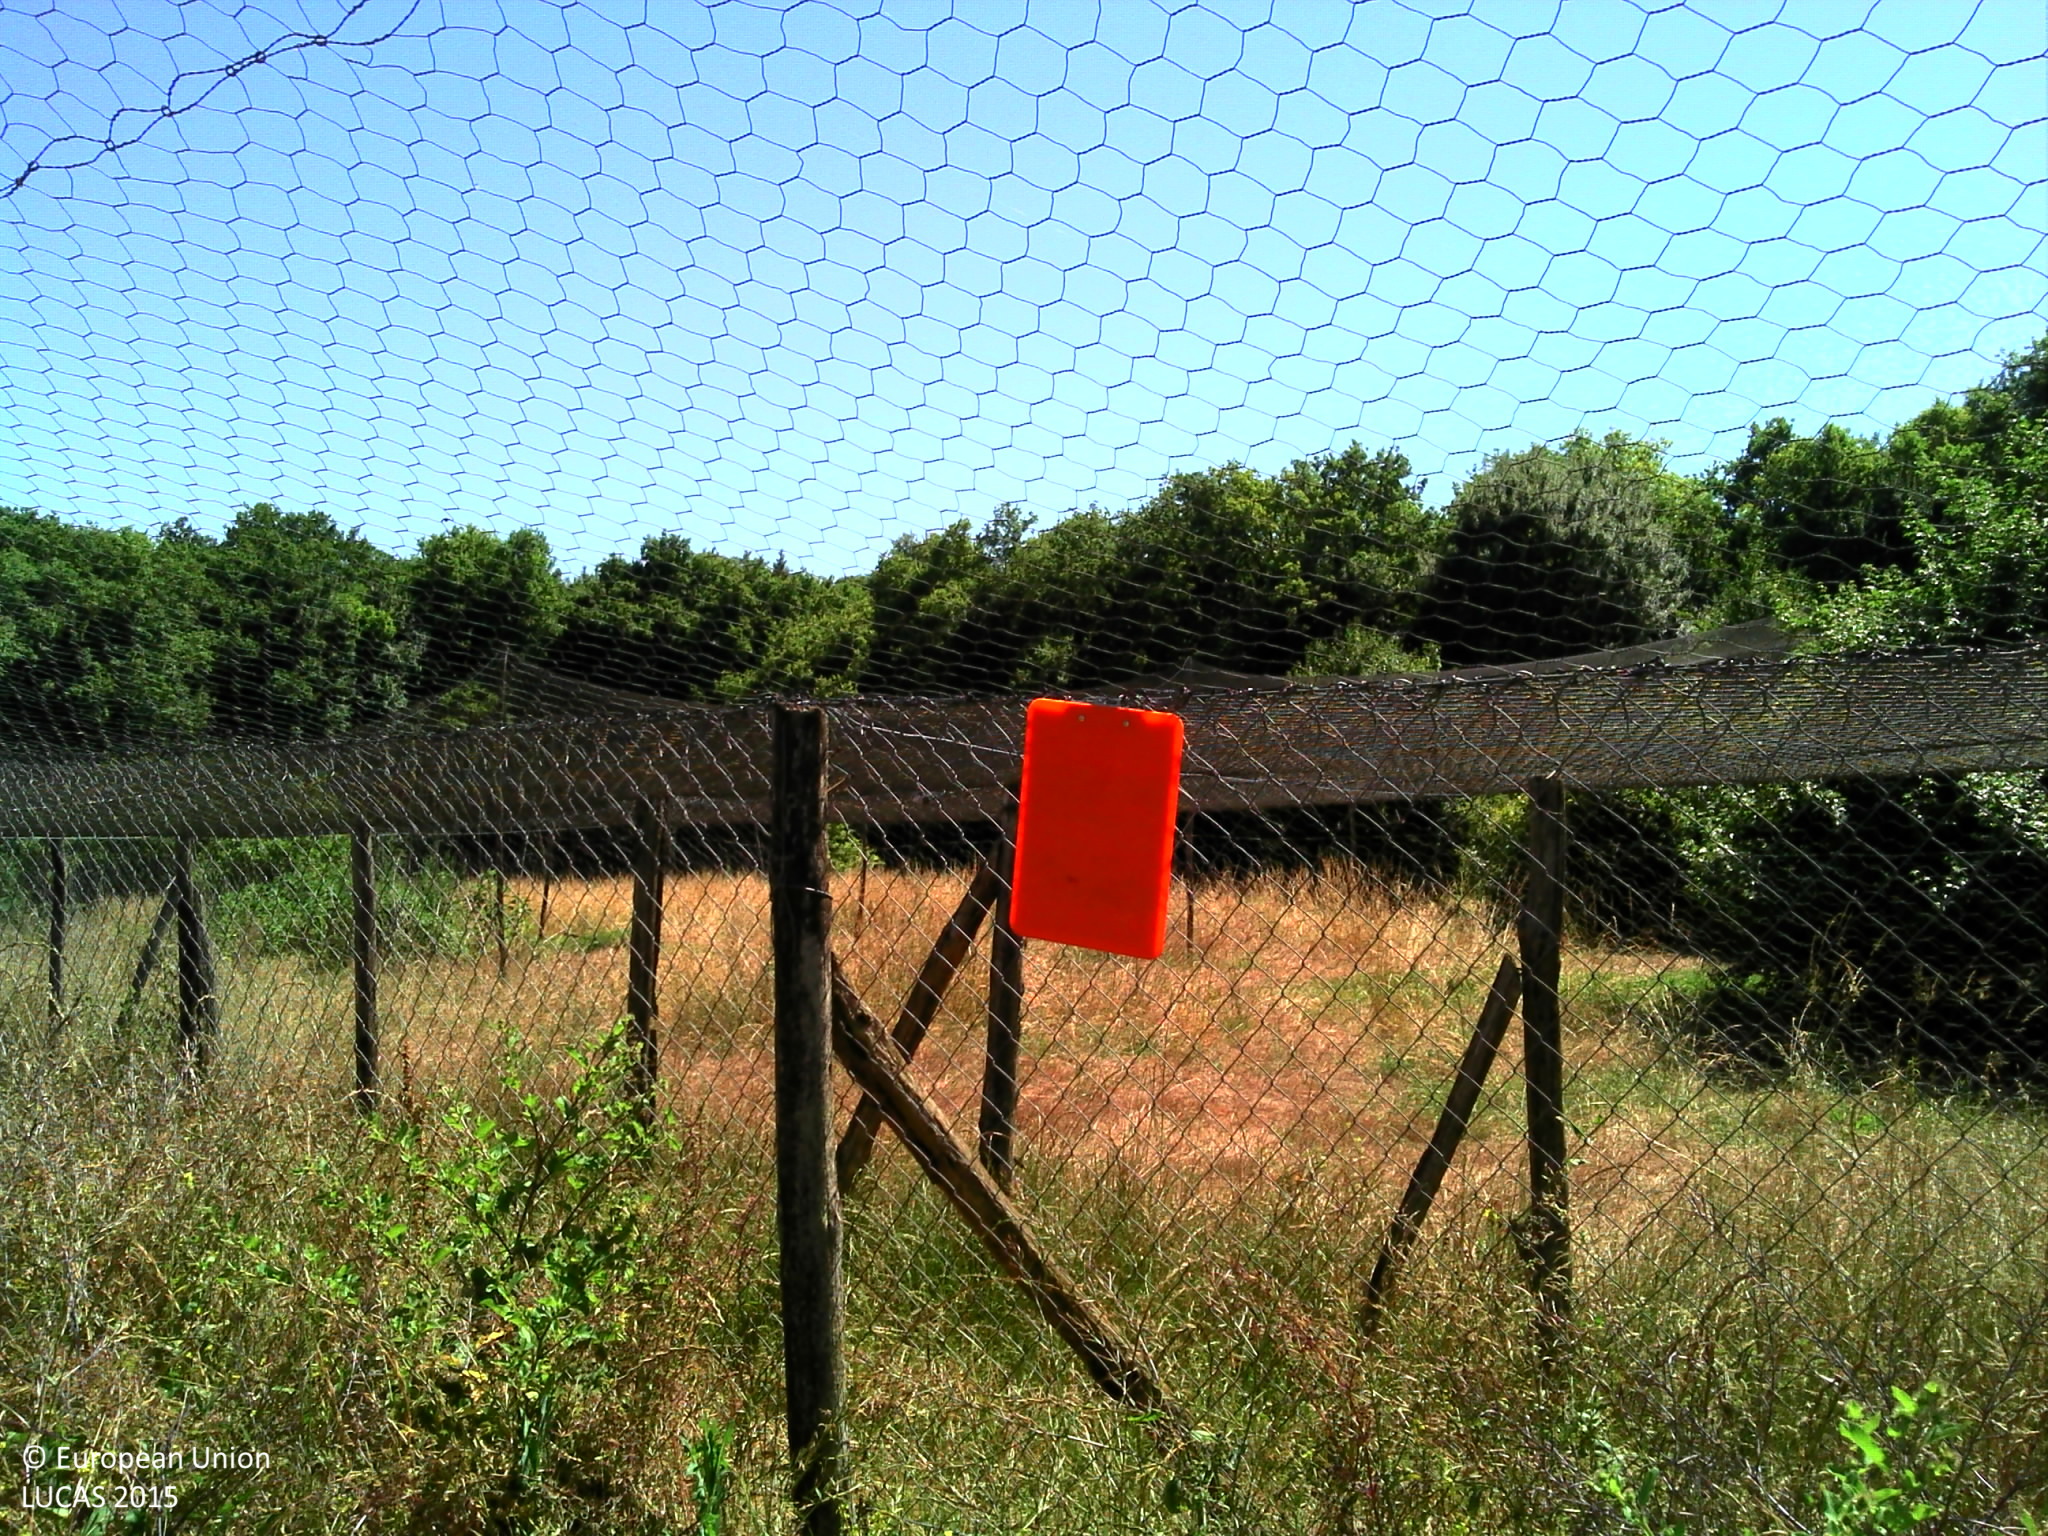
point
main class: Grassland
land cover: Grassland with sparse tree/shrub cover
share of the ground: > 75 %
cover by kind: herbaceous plants 95 %, broadleaved forest trees 5 %
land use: Agriculture (excluding fallow land and kitchen gardens)
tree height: < 5 m
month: June
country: FR
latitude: 45.5596
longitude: 0.4420
